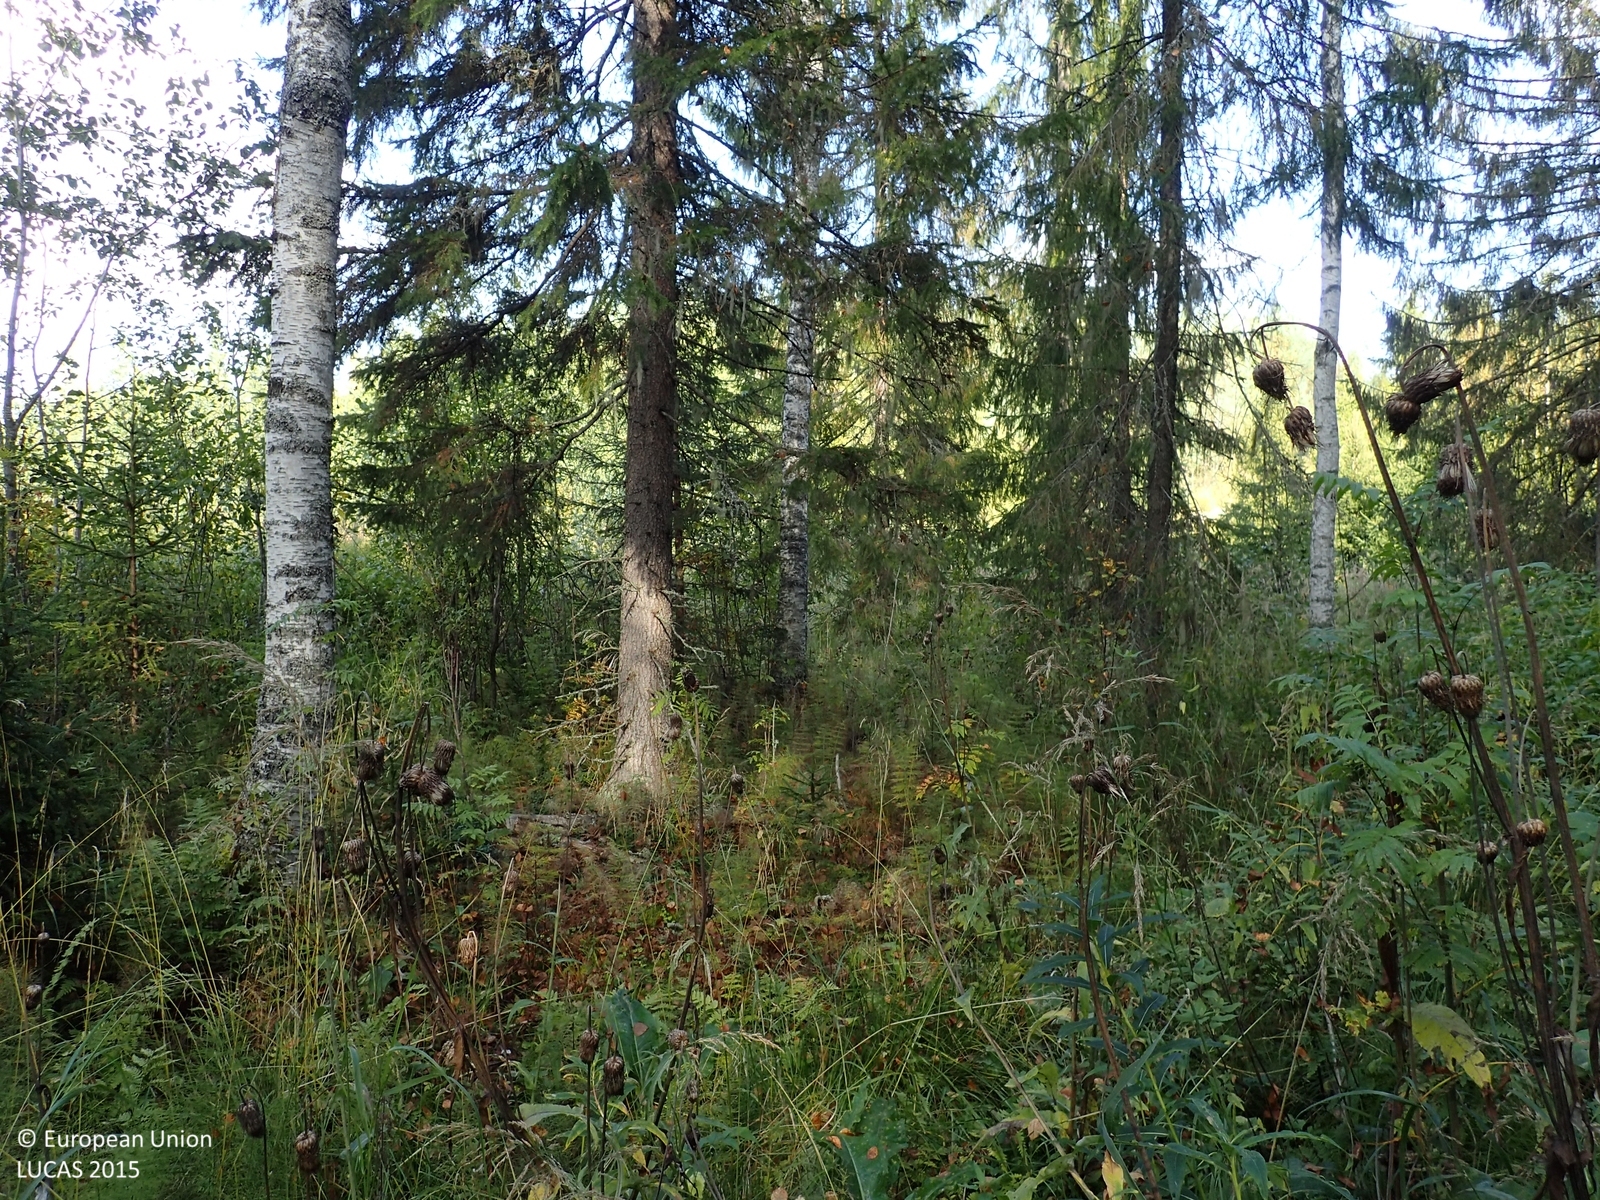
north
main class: Woodland
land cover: Spruce dominated coniferous woodland
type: boreal forest
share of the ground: > 75 %
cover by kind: coniferous forest trees 70 %, herbaceous plants 20 %, broadleaved forest trees 5 %, shrubs 5 %
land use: Forestry
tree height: > 5 m
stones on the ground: < 10 %
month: September
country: FI
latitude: 63.1859
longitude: 25.5042
